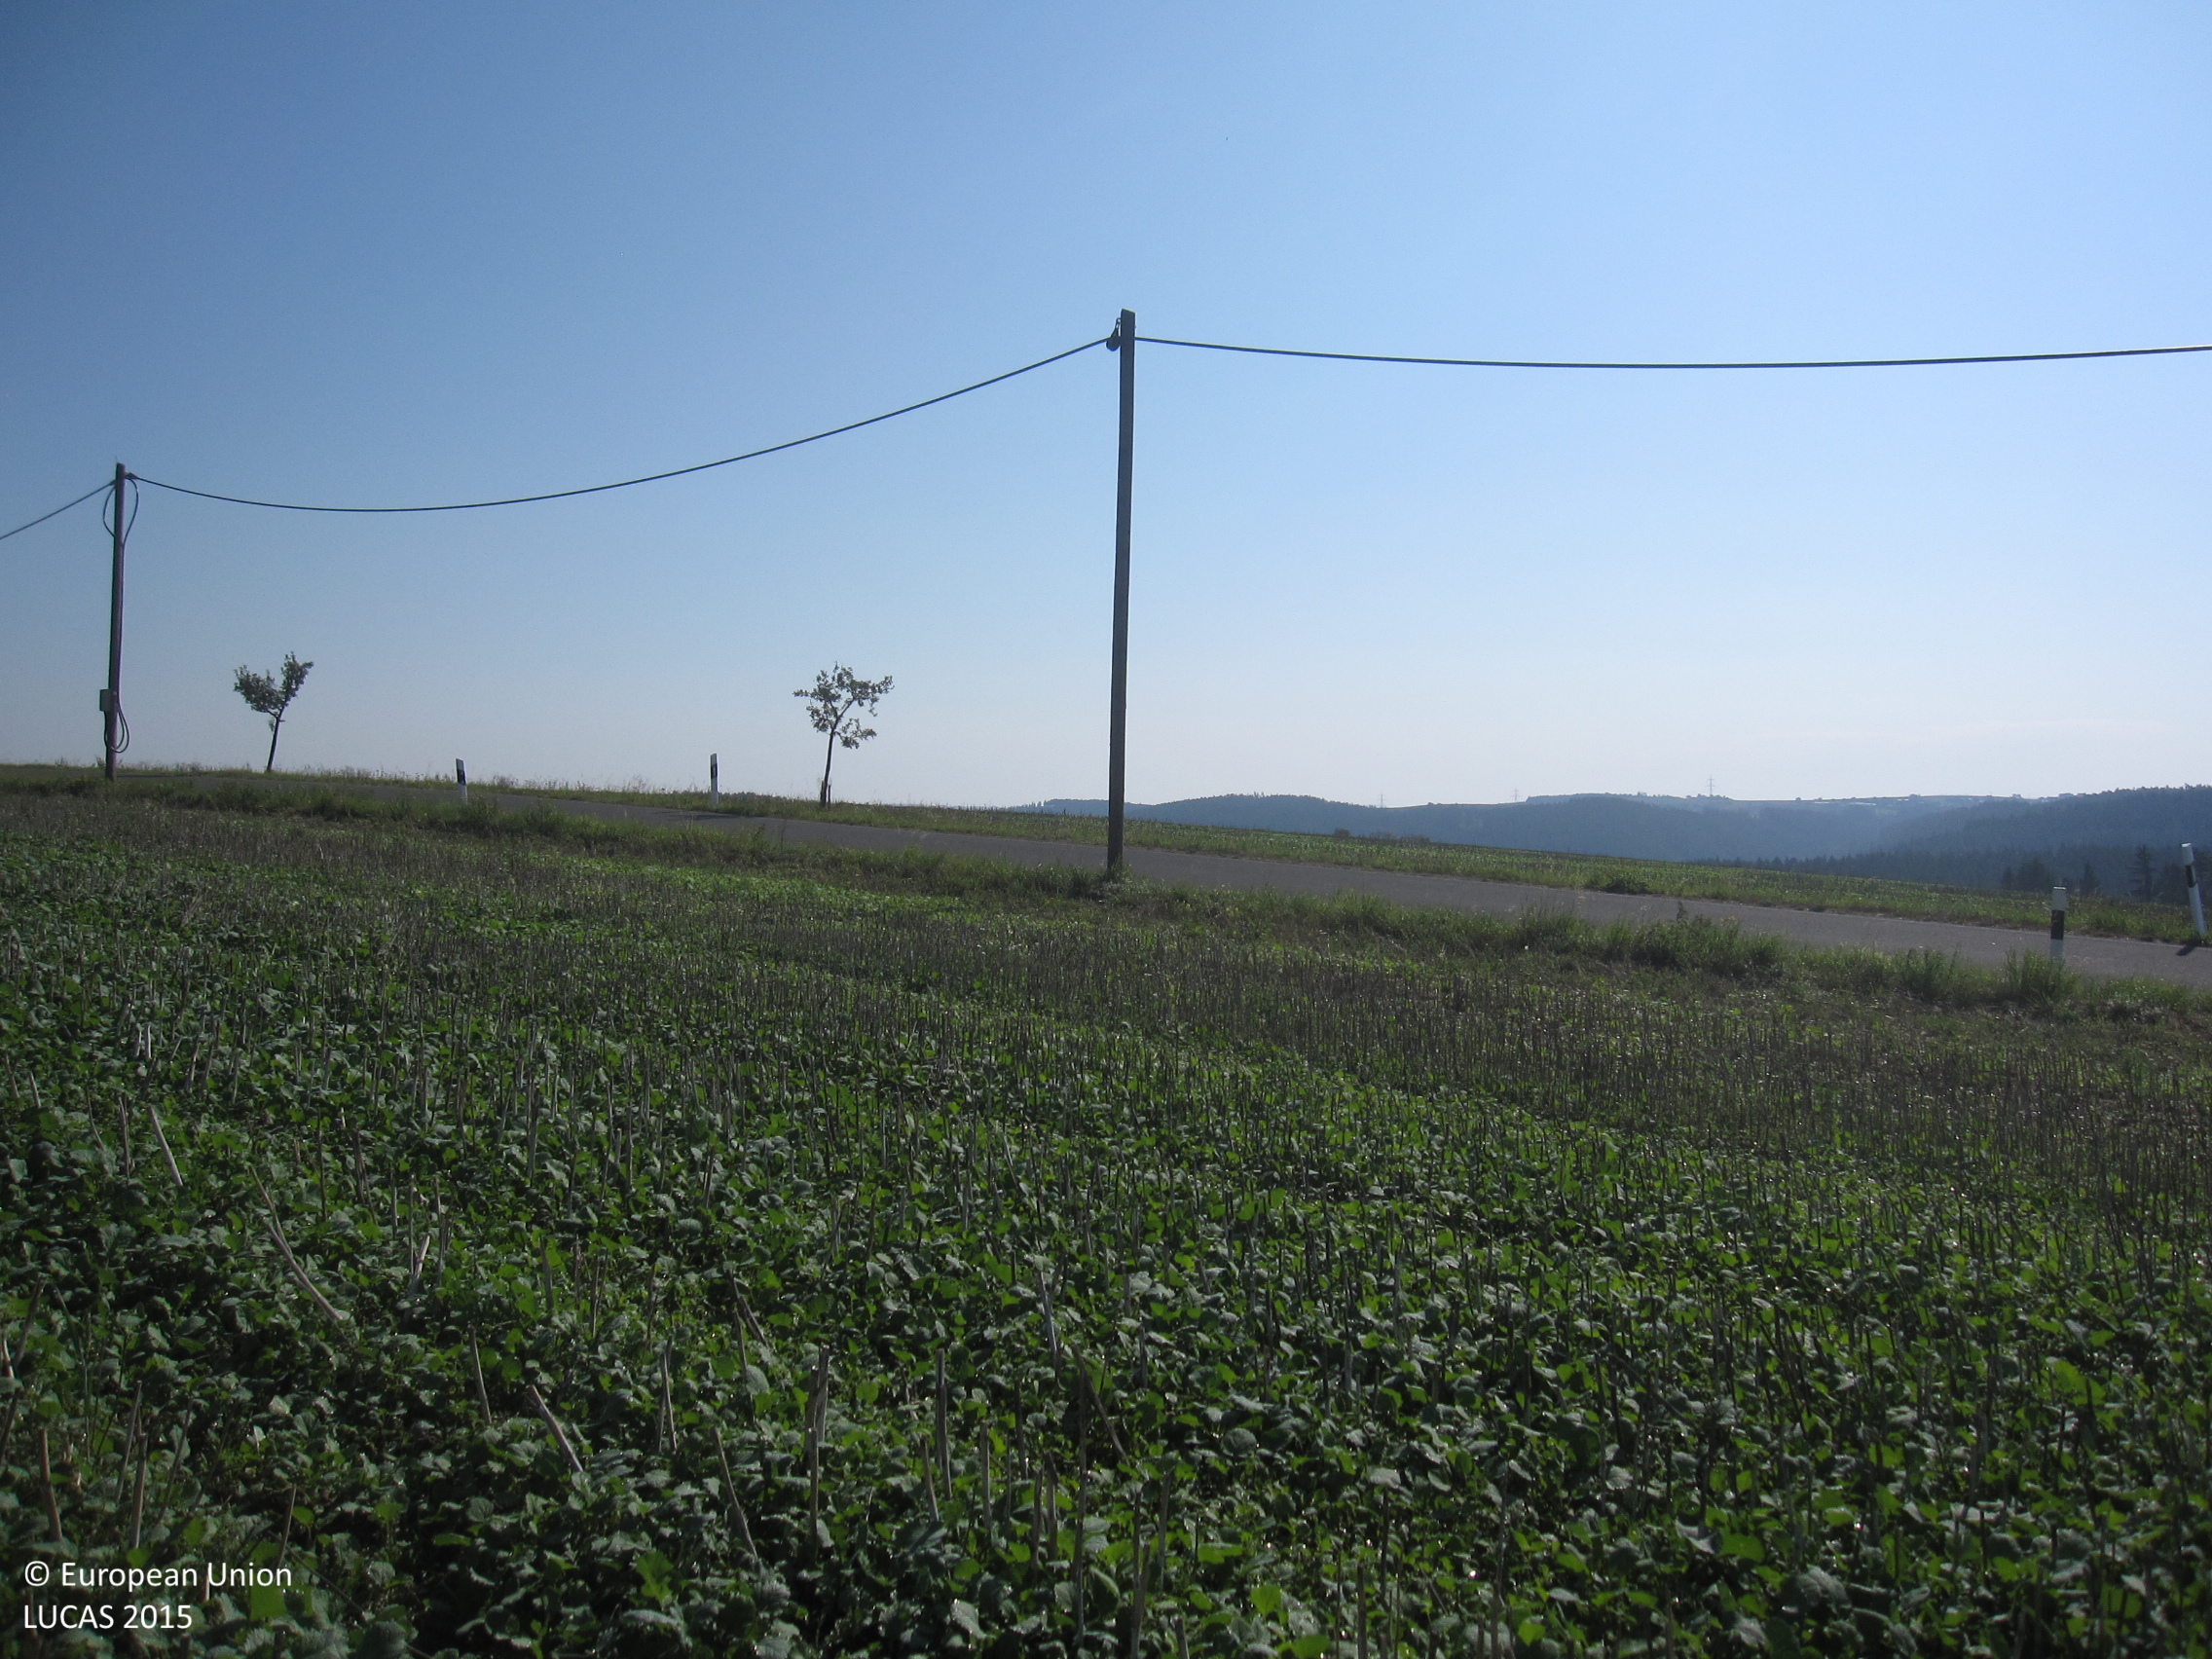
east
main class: Cropland
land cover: Rape and turnip rape
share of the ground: > 75 %
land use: Agriculture (excluding fallow land and kitchen gardens)
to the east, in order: Rape and turnip rape; Electric lines; Ditches and canals; Paved roads, cycling and walking lanes; Grass margins; Rape and turnip rape
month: August
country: DE
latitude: 50.5867
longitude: 11.5957
